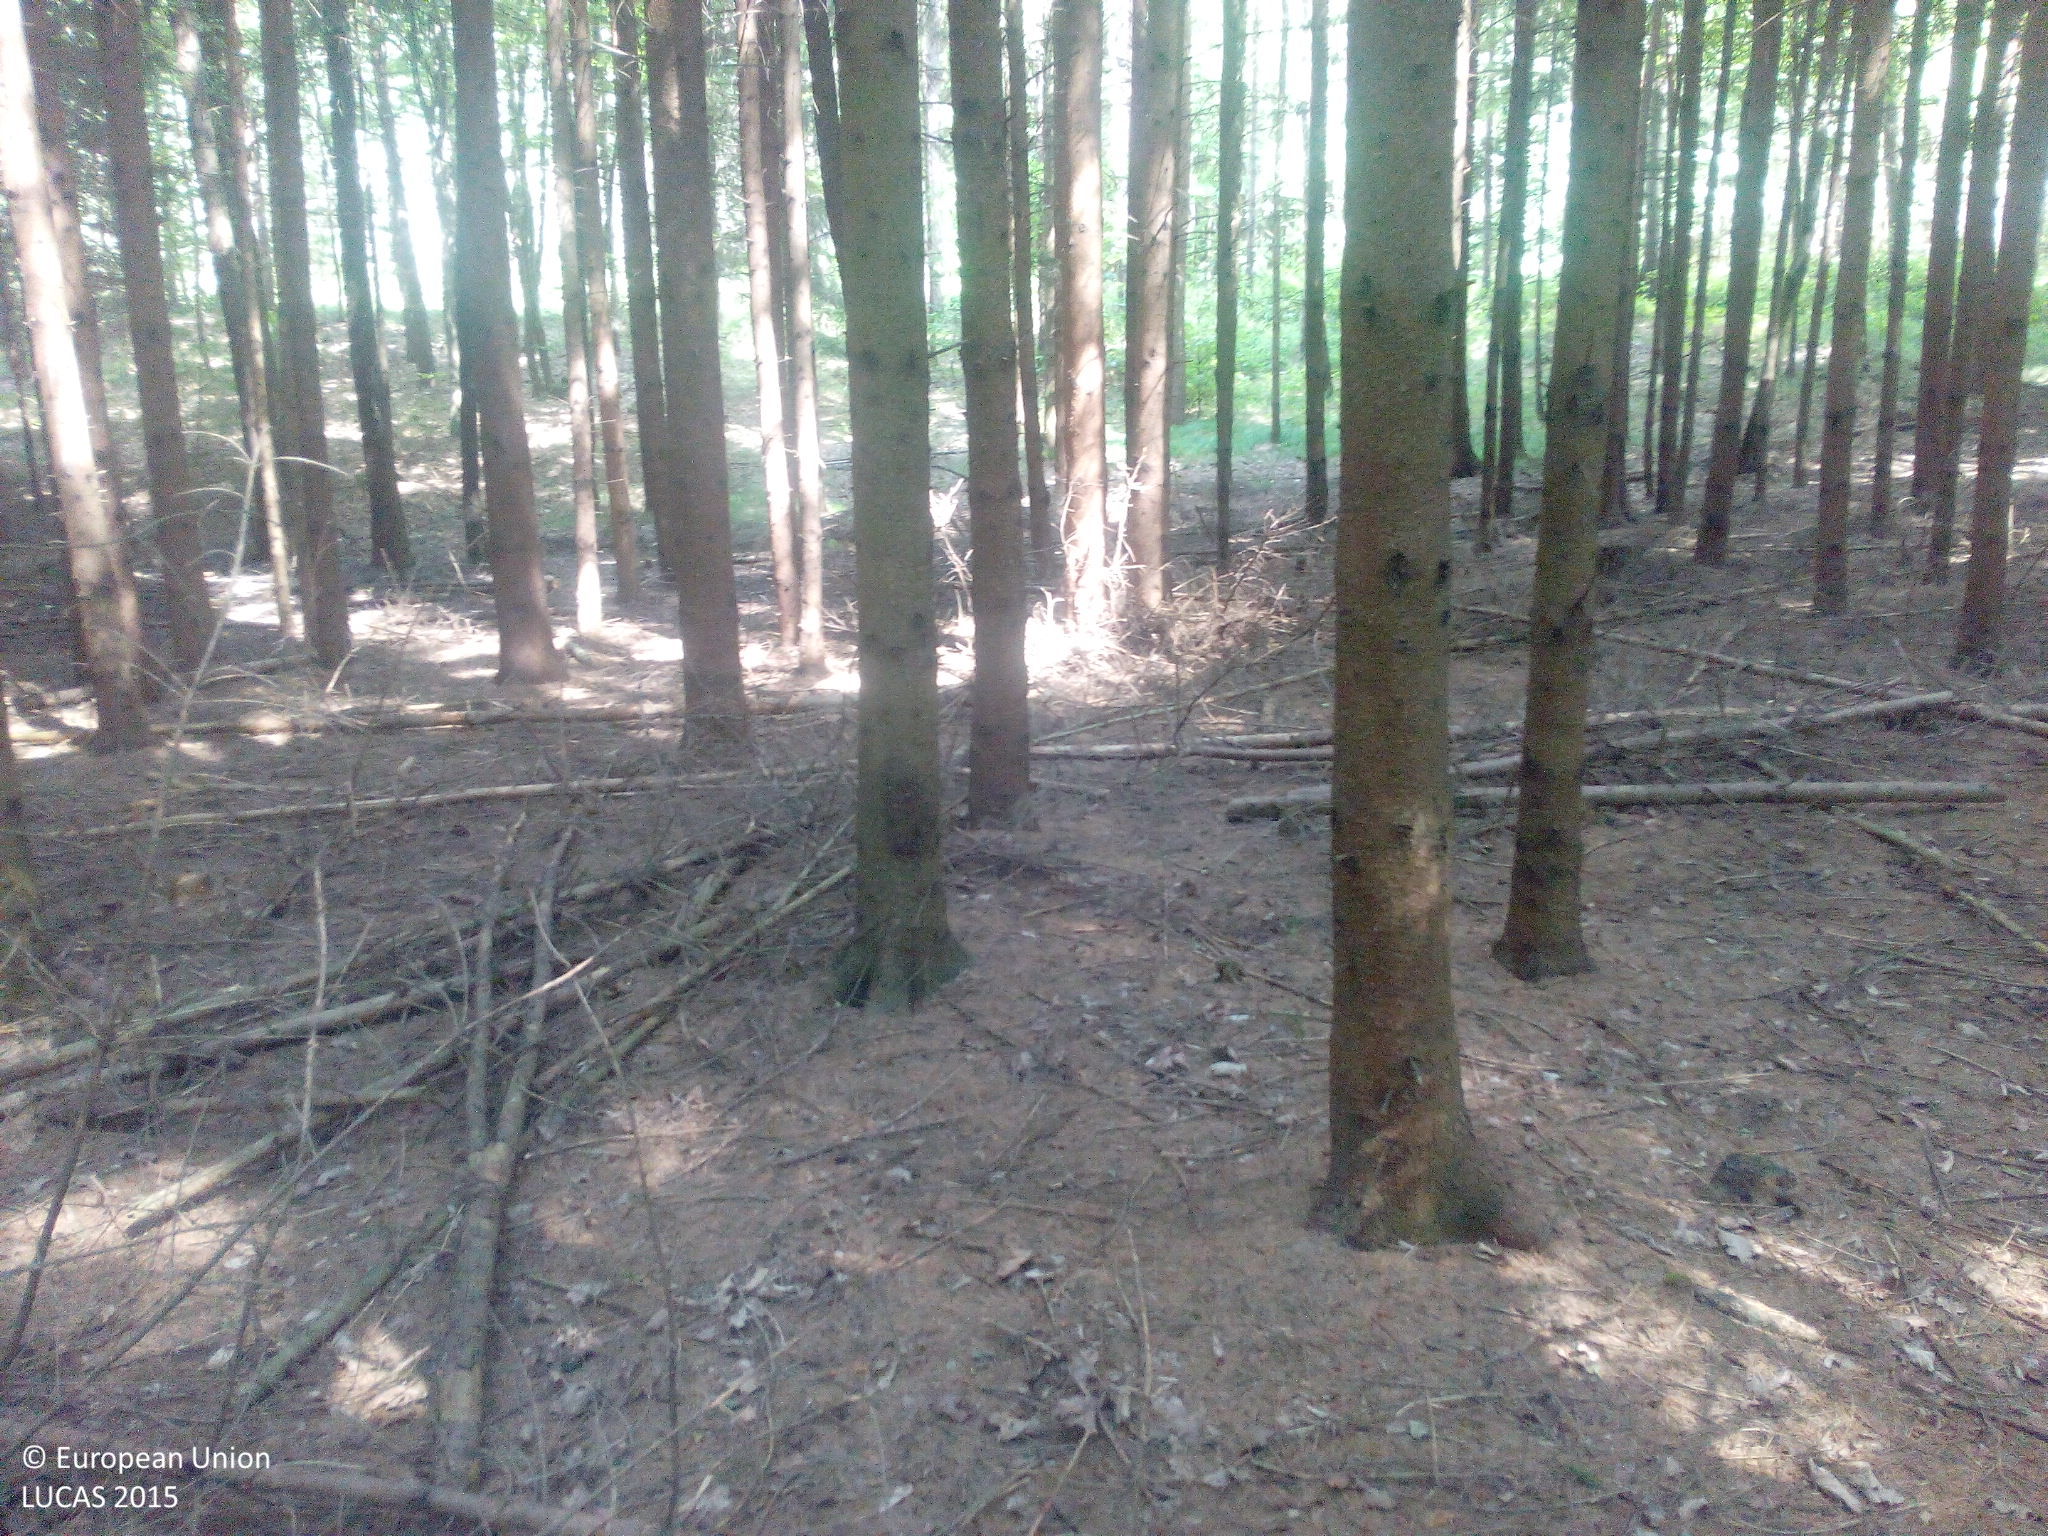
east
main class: Woodland
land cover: Spruce dominated coniferous woodland
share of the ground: > 75 %
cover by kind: coniferous forest trees 95 %, unconsolidated bare surface 5 %
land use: Forestry
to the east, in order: Spruce dominated coniferous woodland; Tracks; Other mixed woodland; Grass margins; Paved roads, cycling and walking lanes; Grass margins; Ditches and canals; Grass margins; Pine dominated mixed woodland; Tracks; Pine dominated mixed woodland
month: July
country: DE
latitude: 49.7670
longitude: 10.9022
